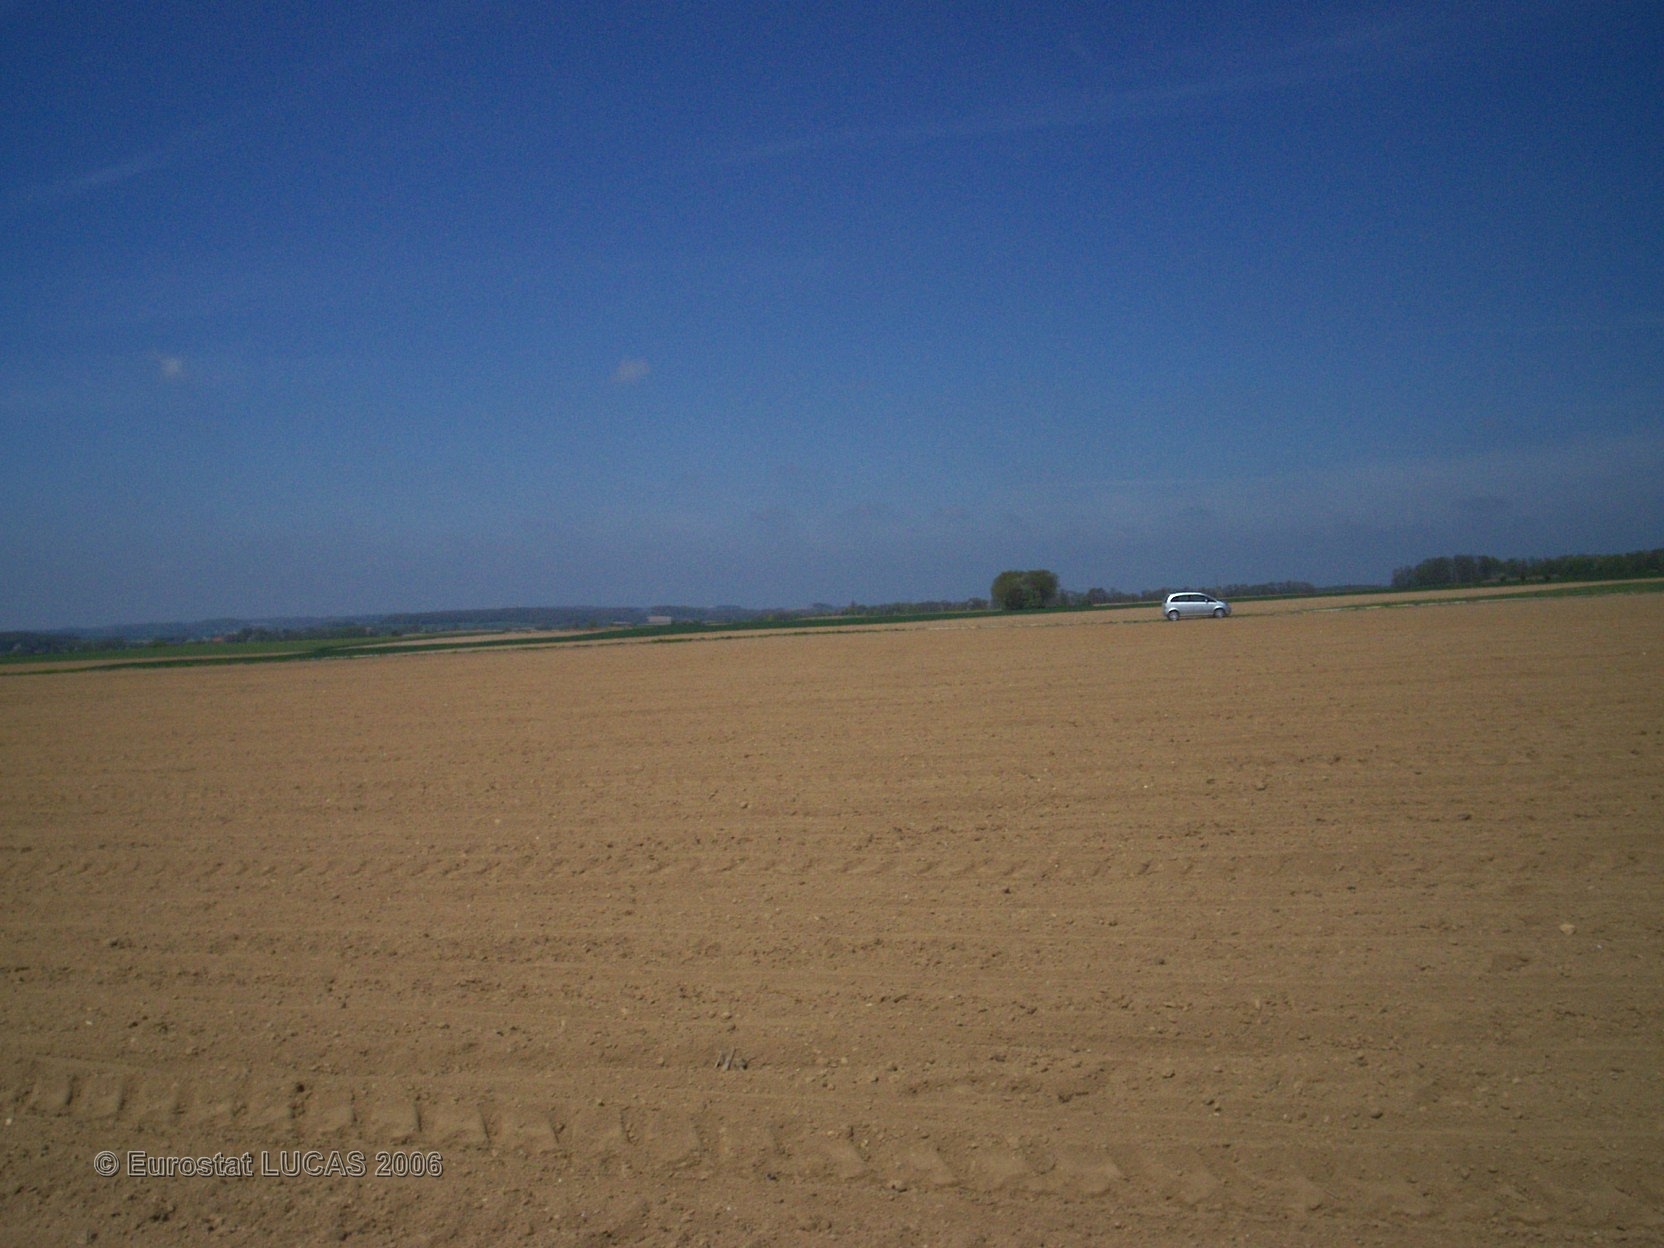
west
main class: Cropland
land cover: Maize
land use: Agriculture (excluding fallow land and kitchen gardens)
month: April
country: FR
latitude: 49.6315
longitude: 4.3885
